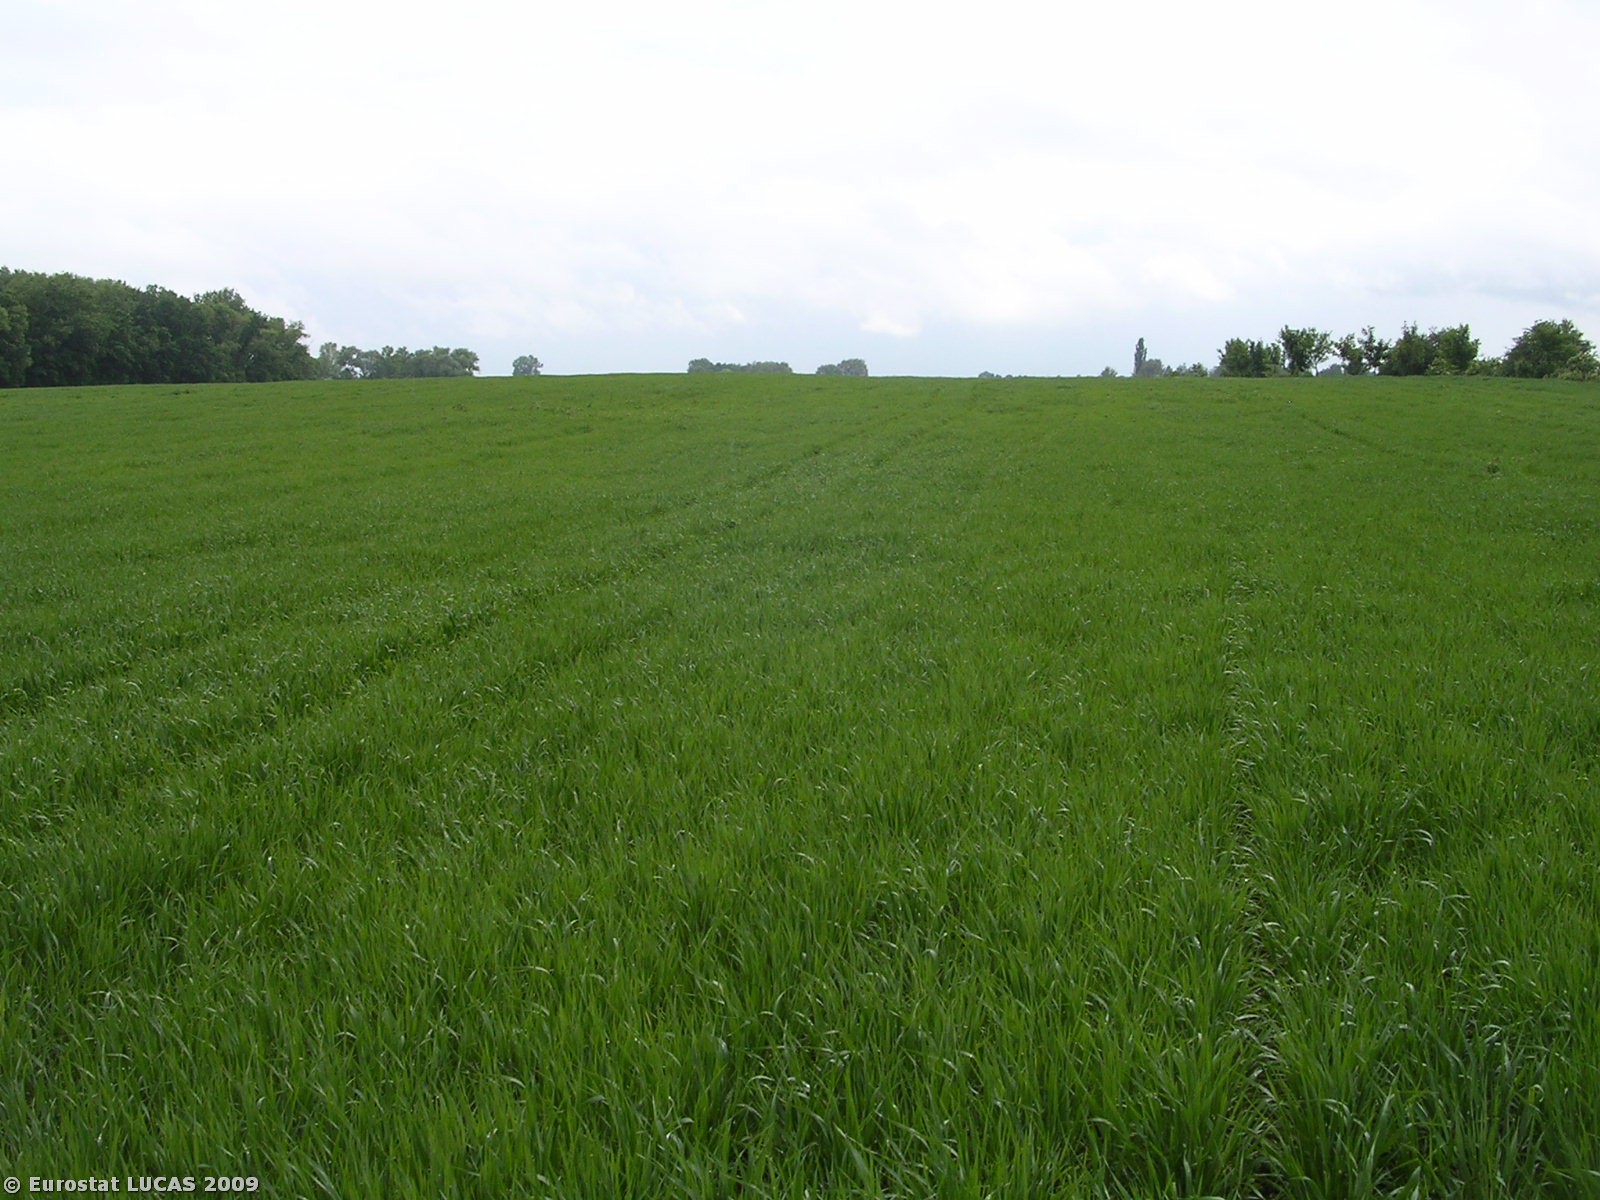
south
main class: Cropland
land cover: Barley
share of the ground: > 75 %
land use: Agriculture (excluding fallow land and kitchen gardens)
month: May
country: CZ
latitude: 50.2681
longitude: 14.2242
